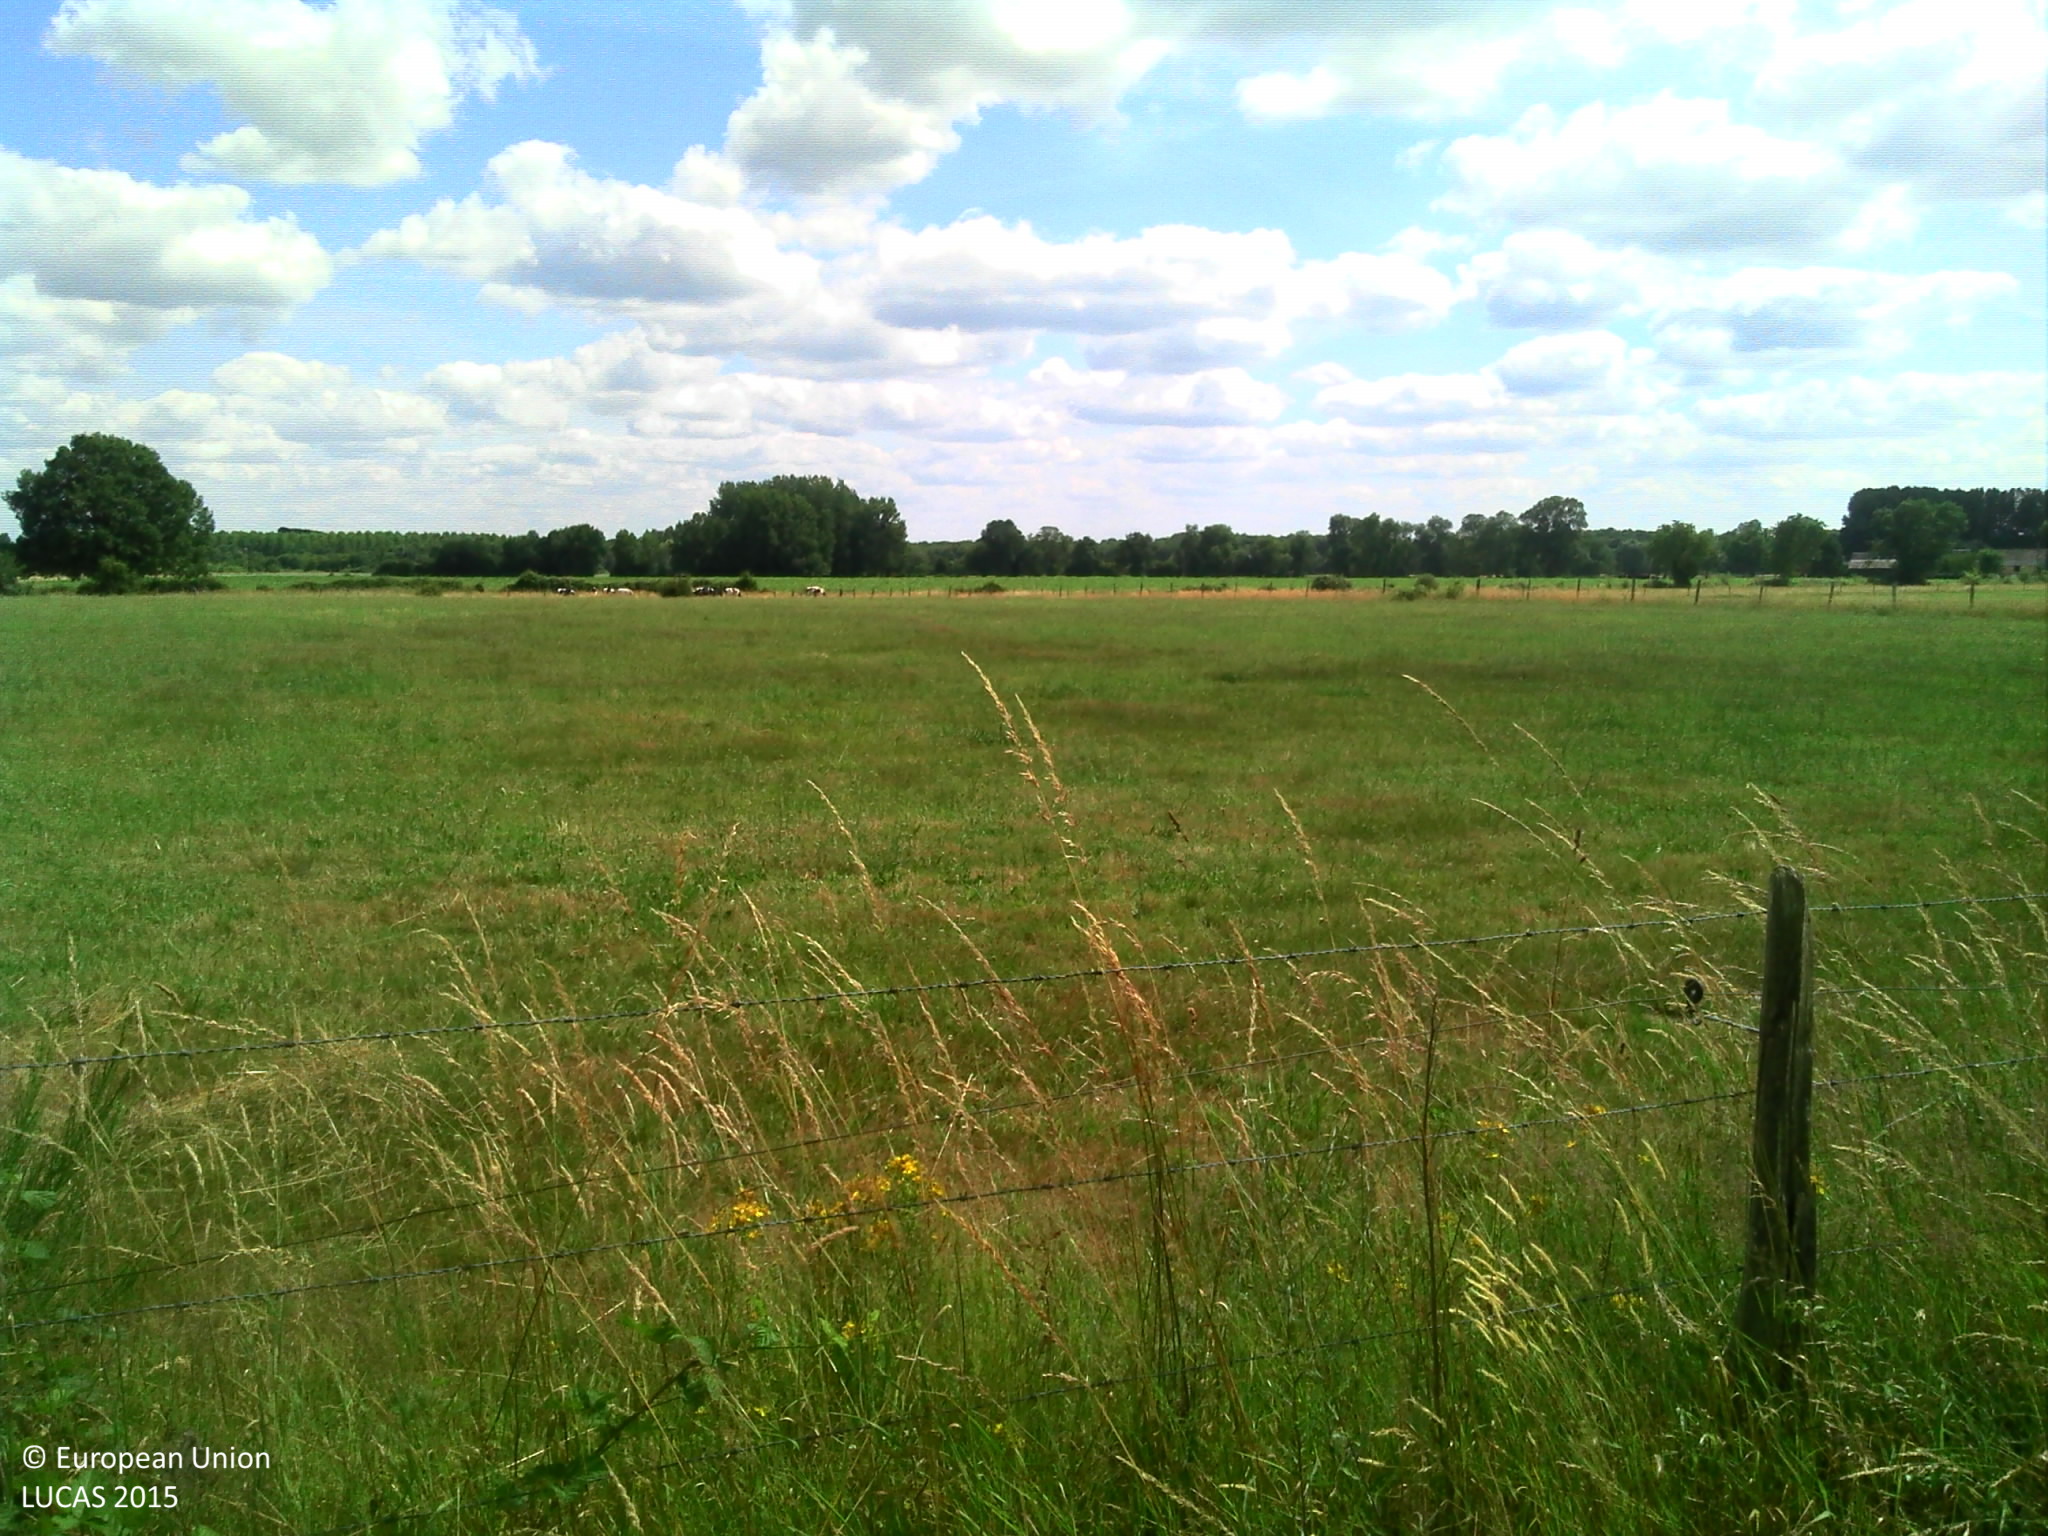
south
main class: Grassland
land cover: Grassland without tree/shrub cover
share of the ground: > 75 %
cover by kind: herbaceous plants 100 %
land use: Agriculture (excluding fallow land and kitchen gardens)
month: June
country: FR
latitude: 47.4714
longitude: 0.3313
